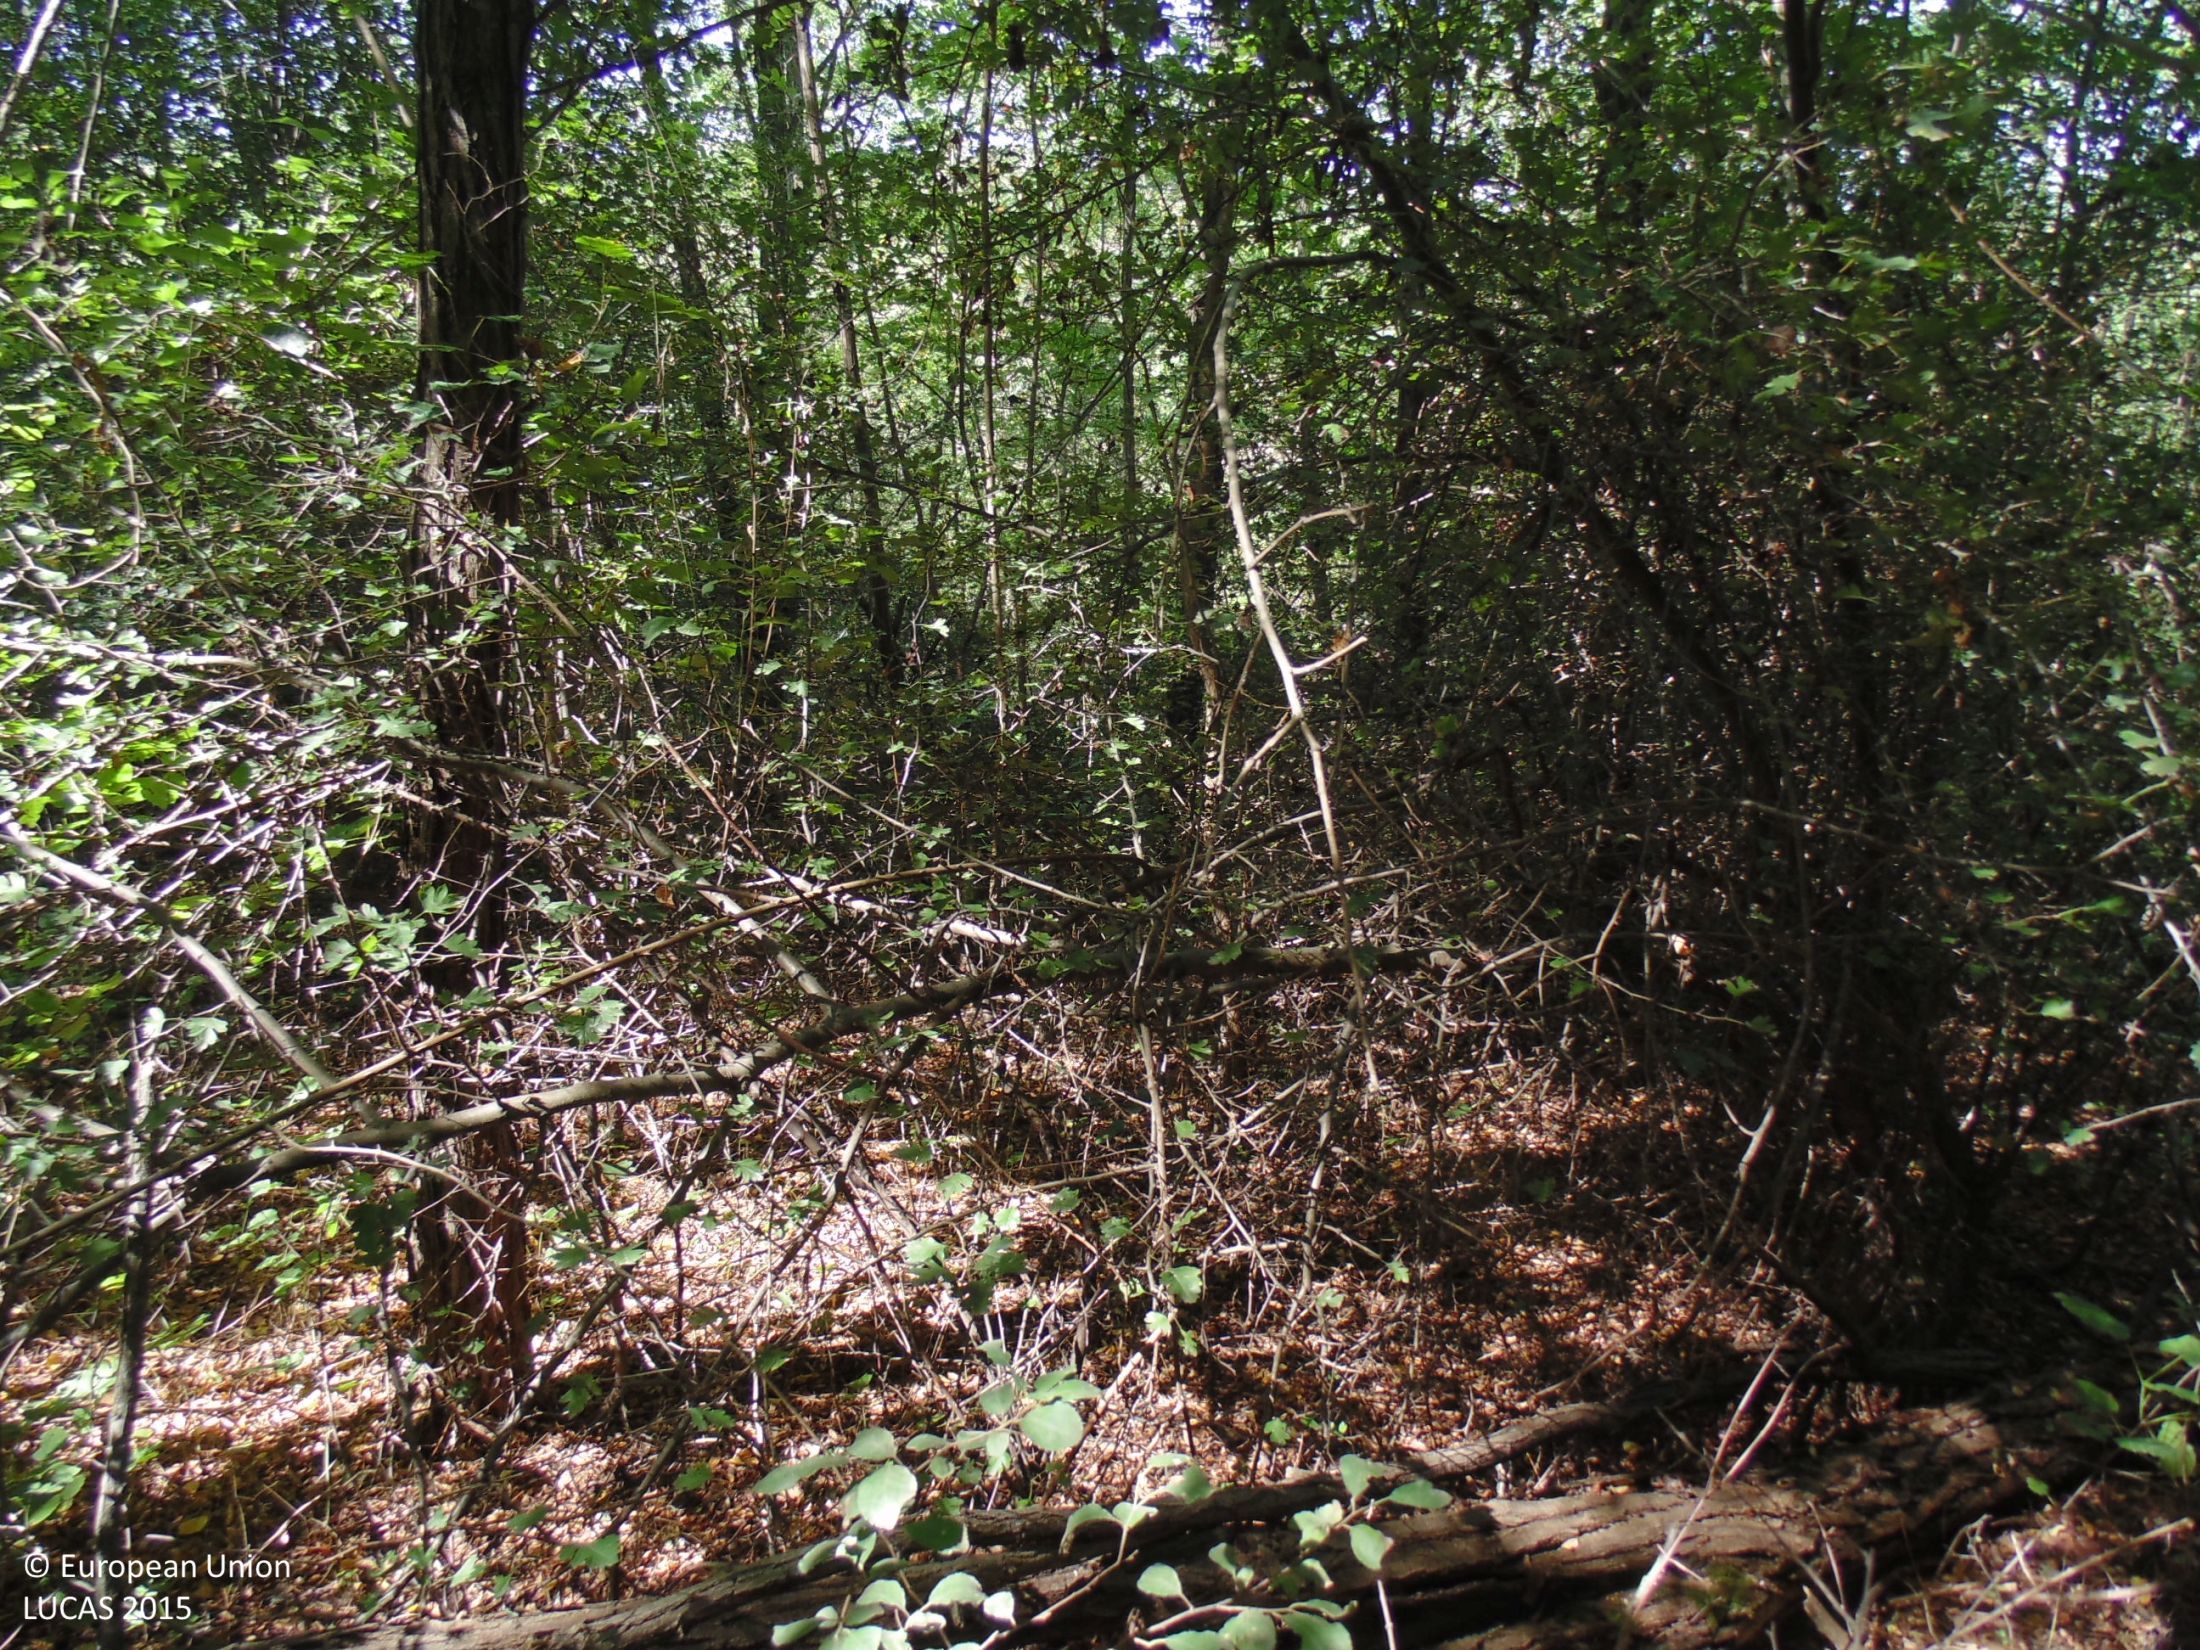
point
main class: Woodland
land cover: Broadleaved woodland
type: mesophytic deciduous forest
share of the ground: > 75 %
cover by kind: broadleaved forest trees 90 %, shrubs 5 %, herbaceous plants 5 %
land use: Forestry
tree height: > 5 m
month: September
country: BG
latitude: 44.0771
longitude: 26.9940
